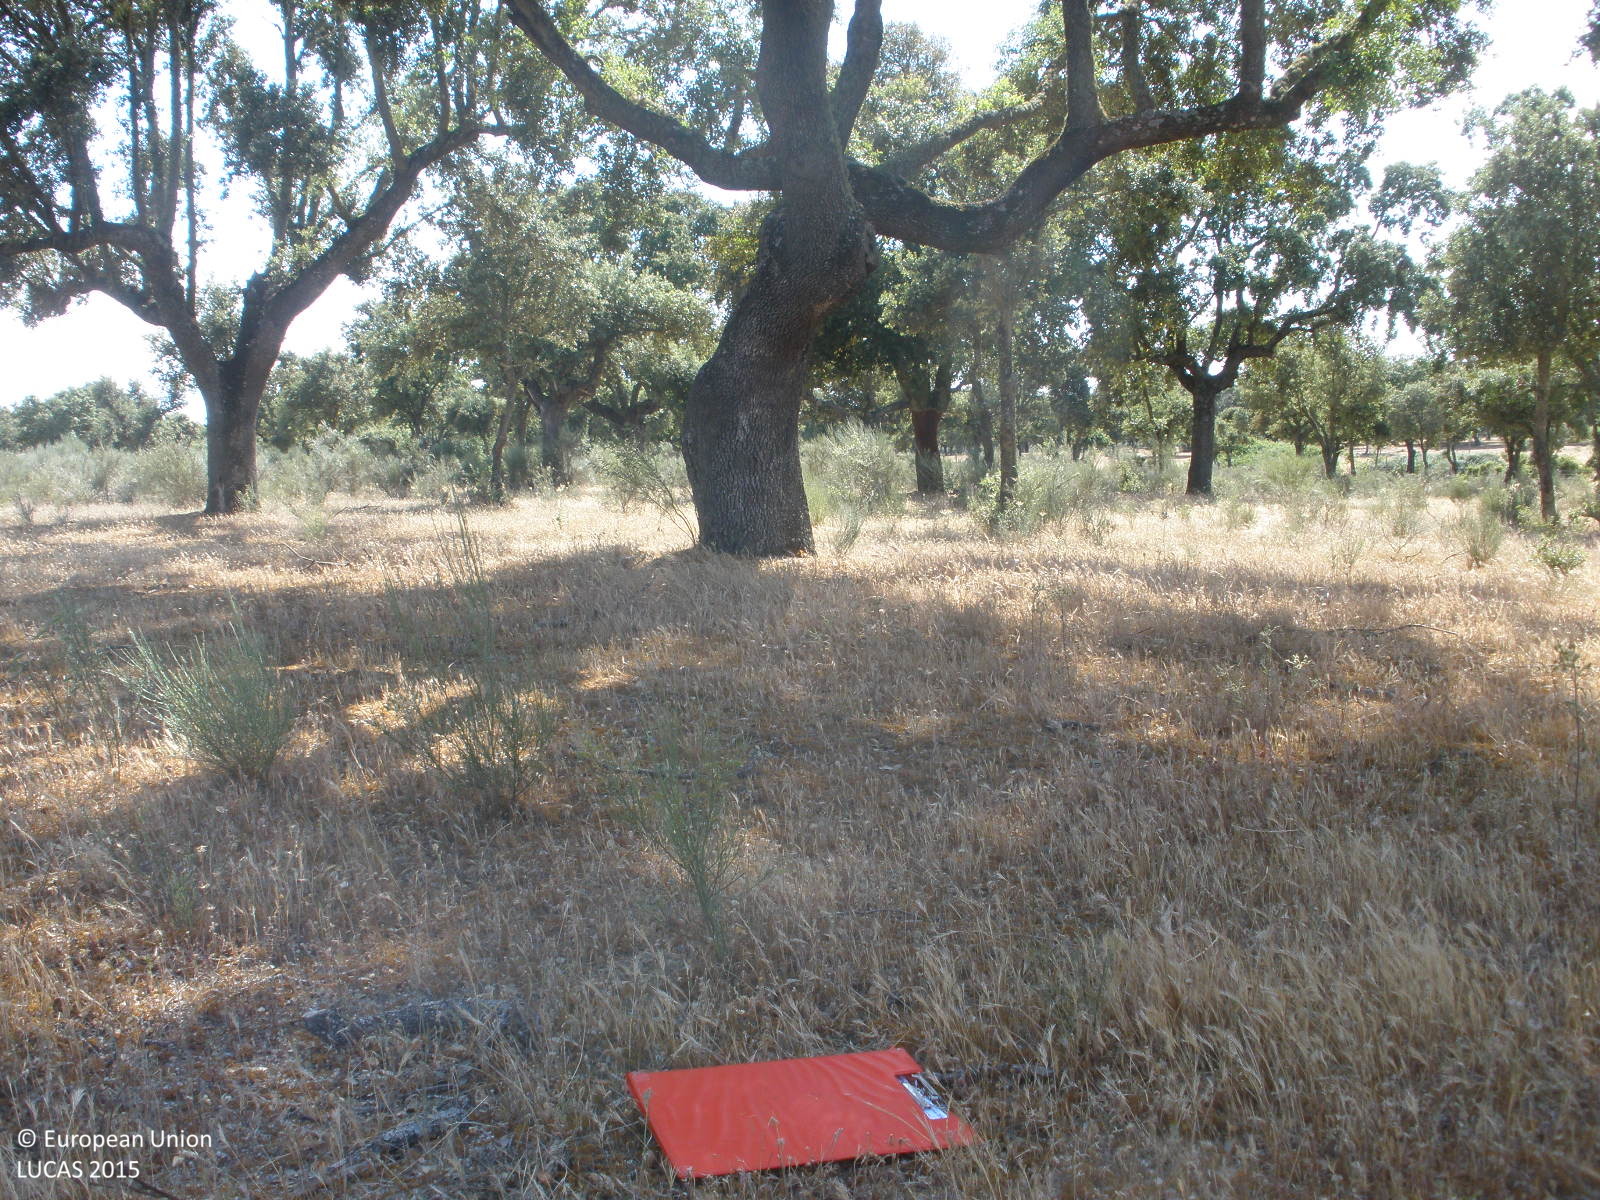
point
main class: Woodland
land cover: Broadleaved woodland
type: broadleaved evergreen forest
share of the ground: 50 - 75 %
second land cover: Grassland without tree/shrub cover
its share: > 75 %
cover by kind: broadleaved forest trees 50 %, herbaceous plants 40 %, shrubs 10 %
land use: Forestry
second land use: Agriculture (excluding fallow land and kitchen gardens)
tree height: > 5 m
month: June
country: ES
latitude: 40.5685
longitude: -6.7367
